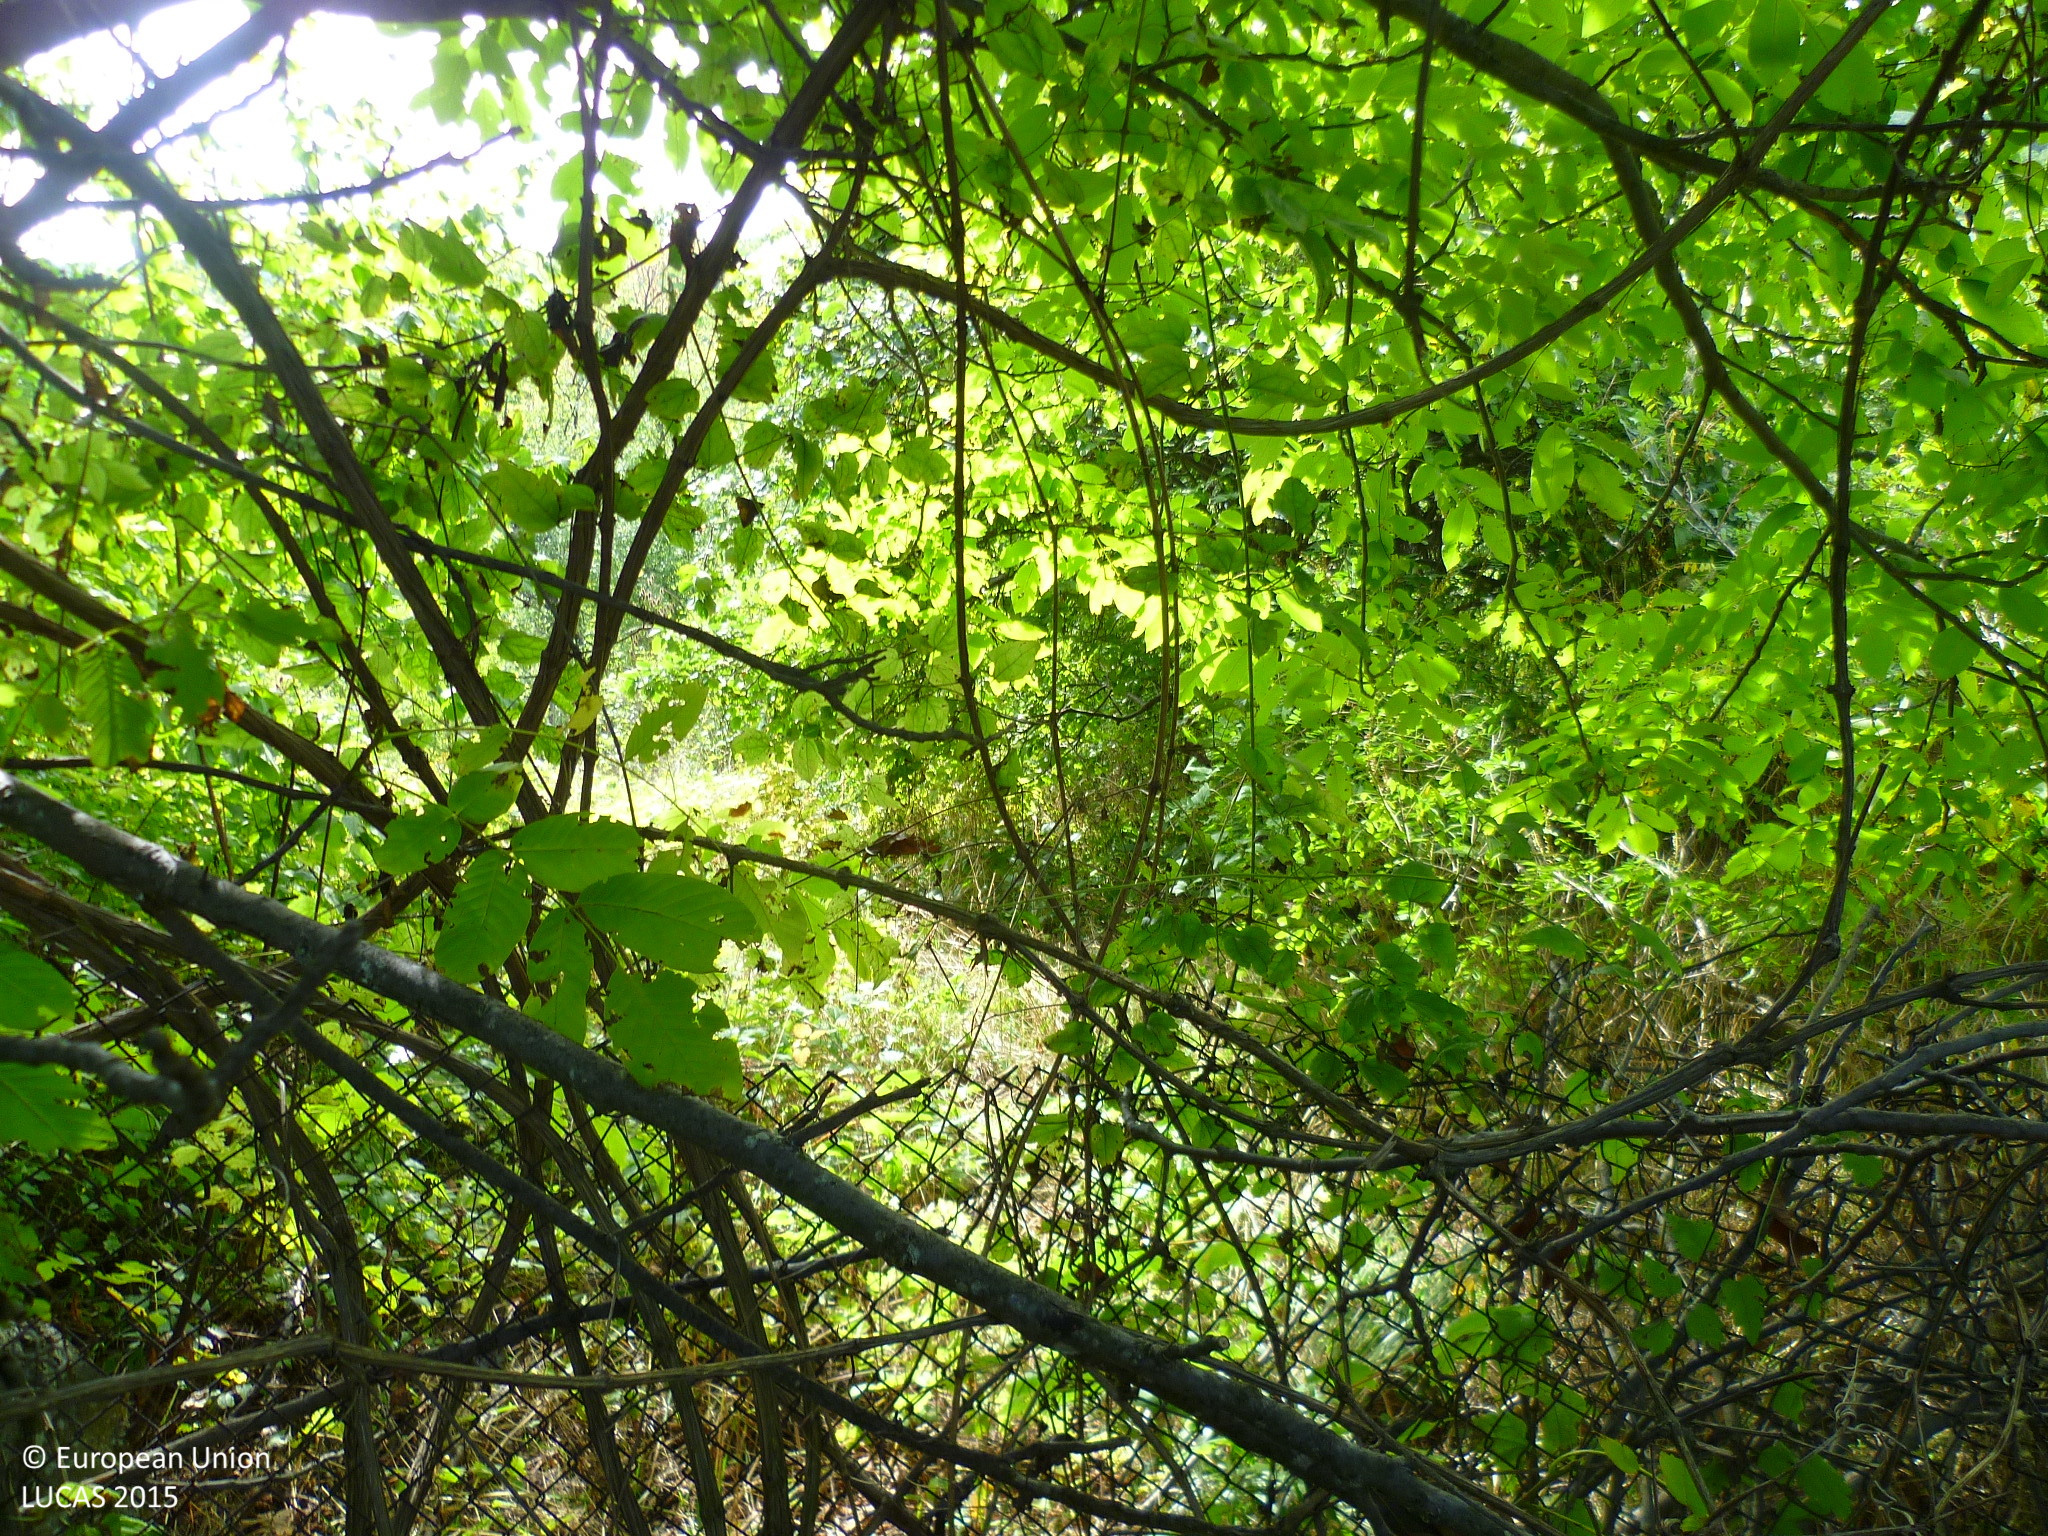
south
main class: Cropland
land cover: Nuts trees
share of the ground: 25 - 50 %
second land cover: Spontaneously vegetated surfaces
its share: 50 - 75 %
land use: Kitchen garden
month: October
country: BG
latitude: 42.8376
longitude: 22.8385
